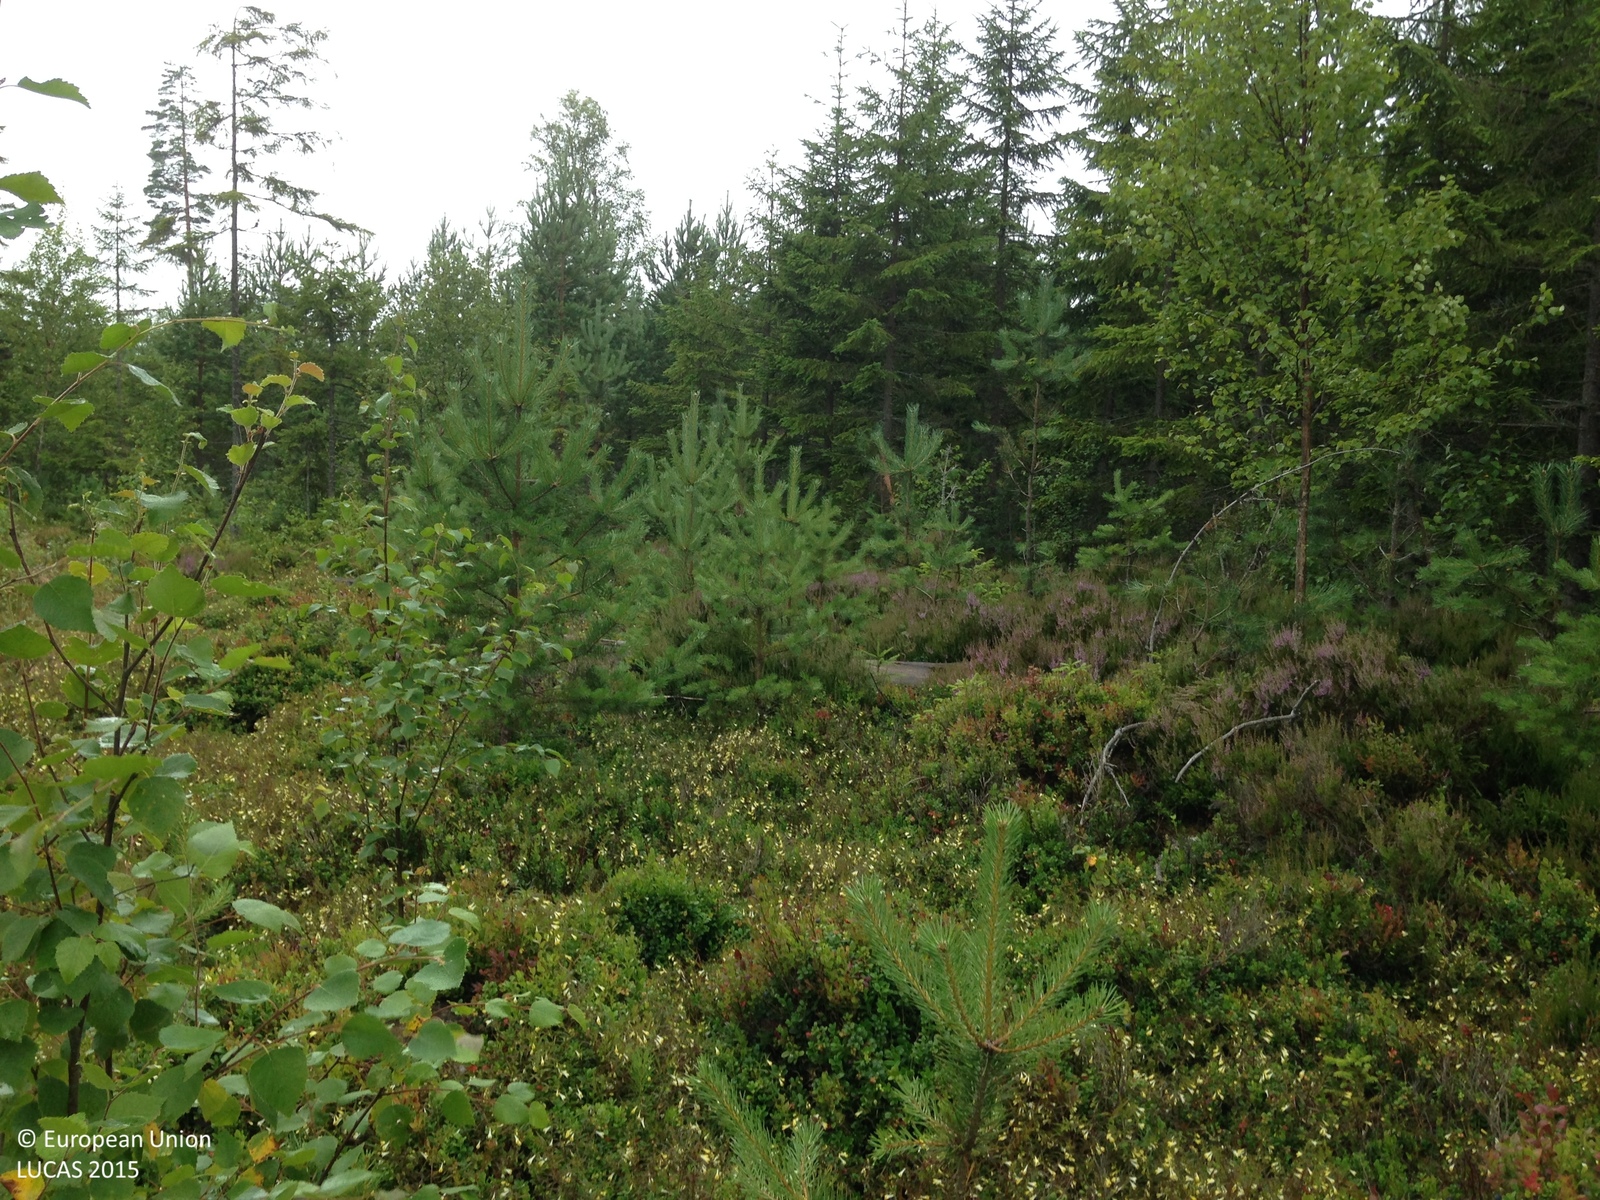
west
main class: Woodland
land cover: Broadleaved woodland
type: hemiboreal forest and nemoral coniferous forest and mixed broadleaved-coniferous forest
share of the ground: 25 - 50 %
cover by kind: broadleaved forest trees 40 %, herbaceous plants 30 %, shrubs 25 %, coniferous forest trees 5 %
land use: Forestry
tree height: < 5 m
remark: Clear cut
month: July
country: SE
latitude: 59.0439
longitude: 14.5413
